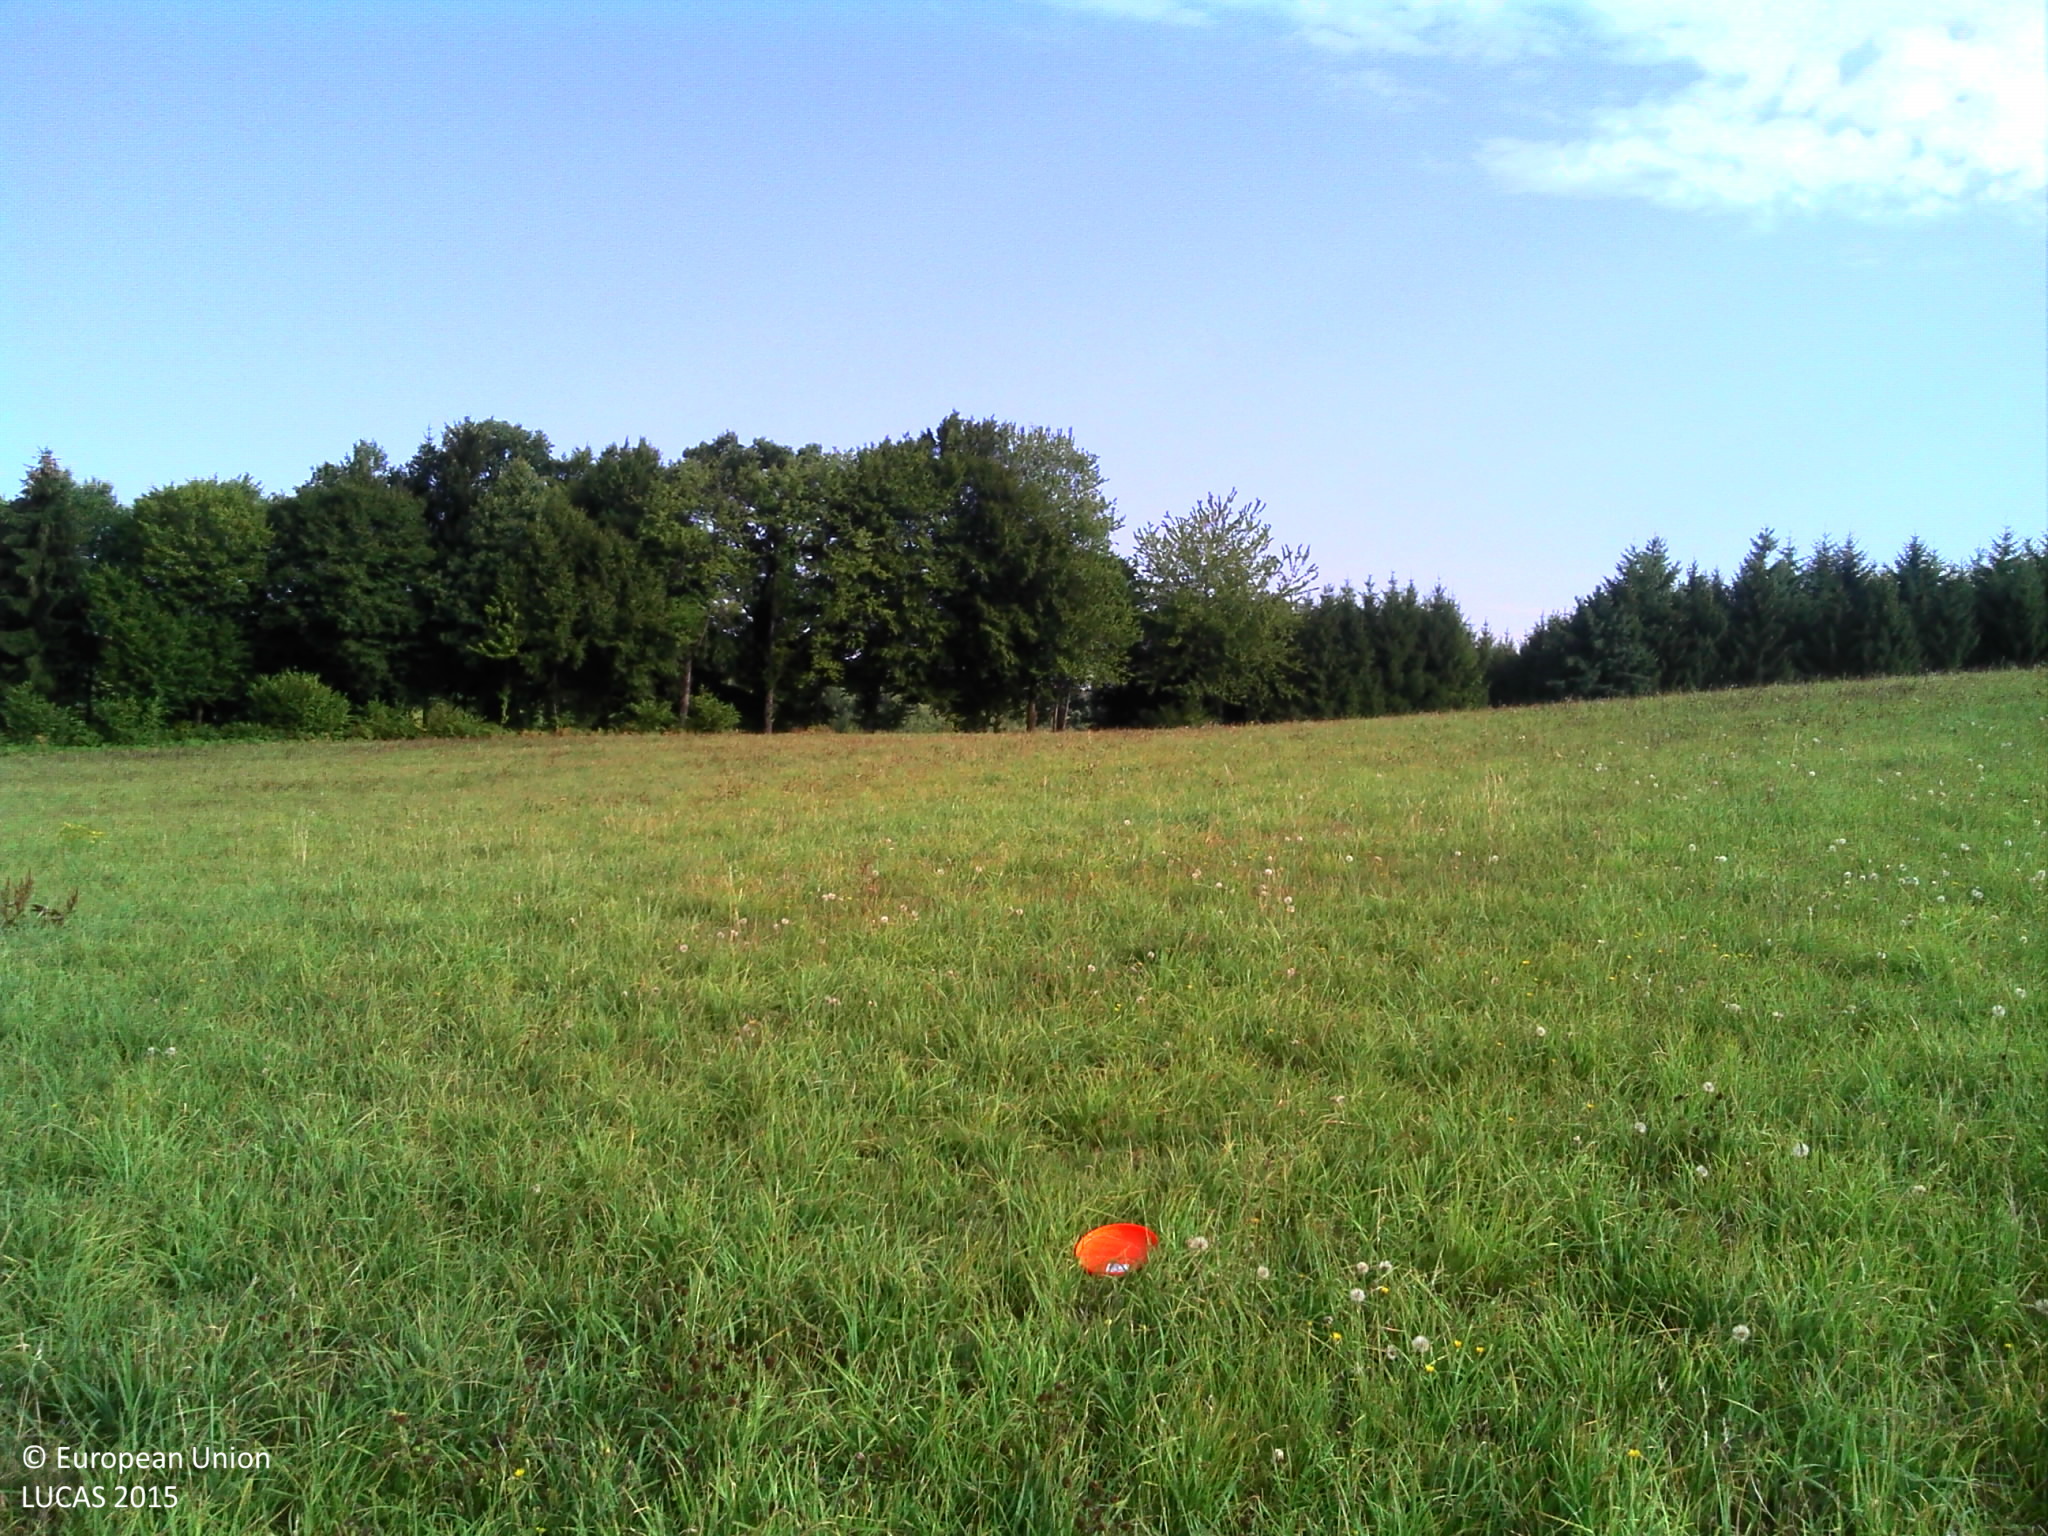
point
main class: Grassland
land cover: Grassland without tree/shrub cover
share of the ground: > 75 %
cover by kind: herbaceous plants 100 %
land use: Agriculture (excluding fallow land and kitchen gardens)
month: August
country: FR
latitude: 48.9468
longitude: 7.3107
